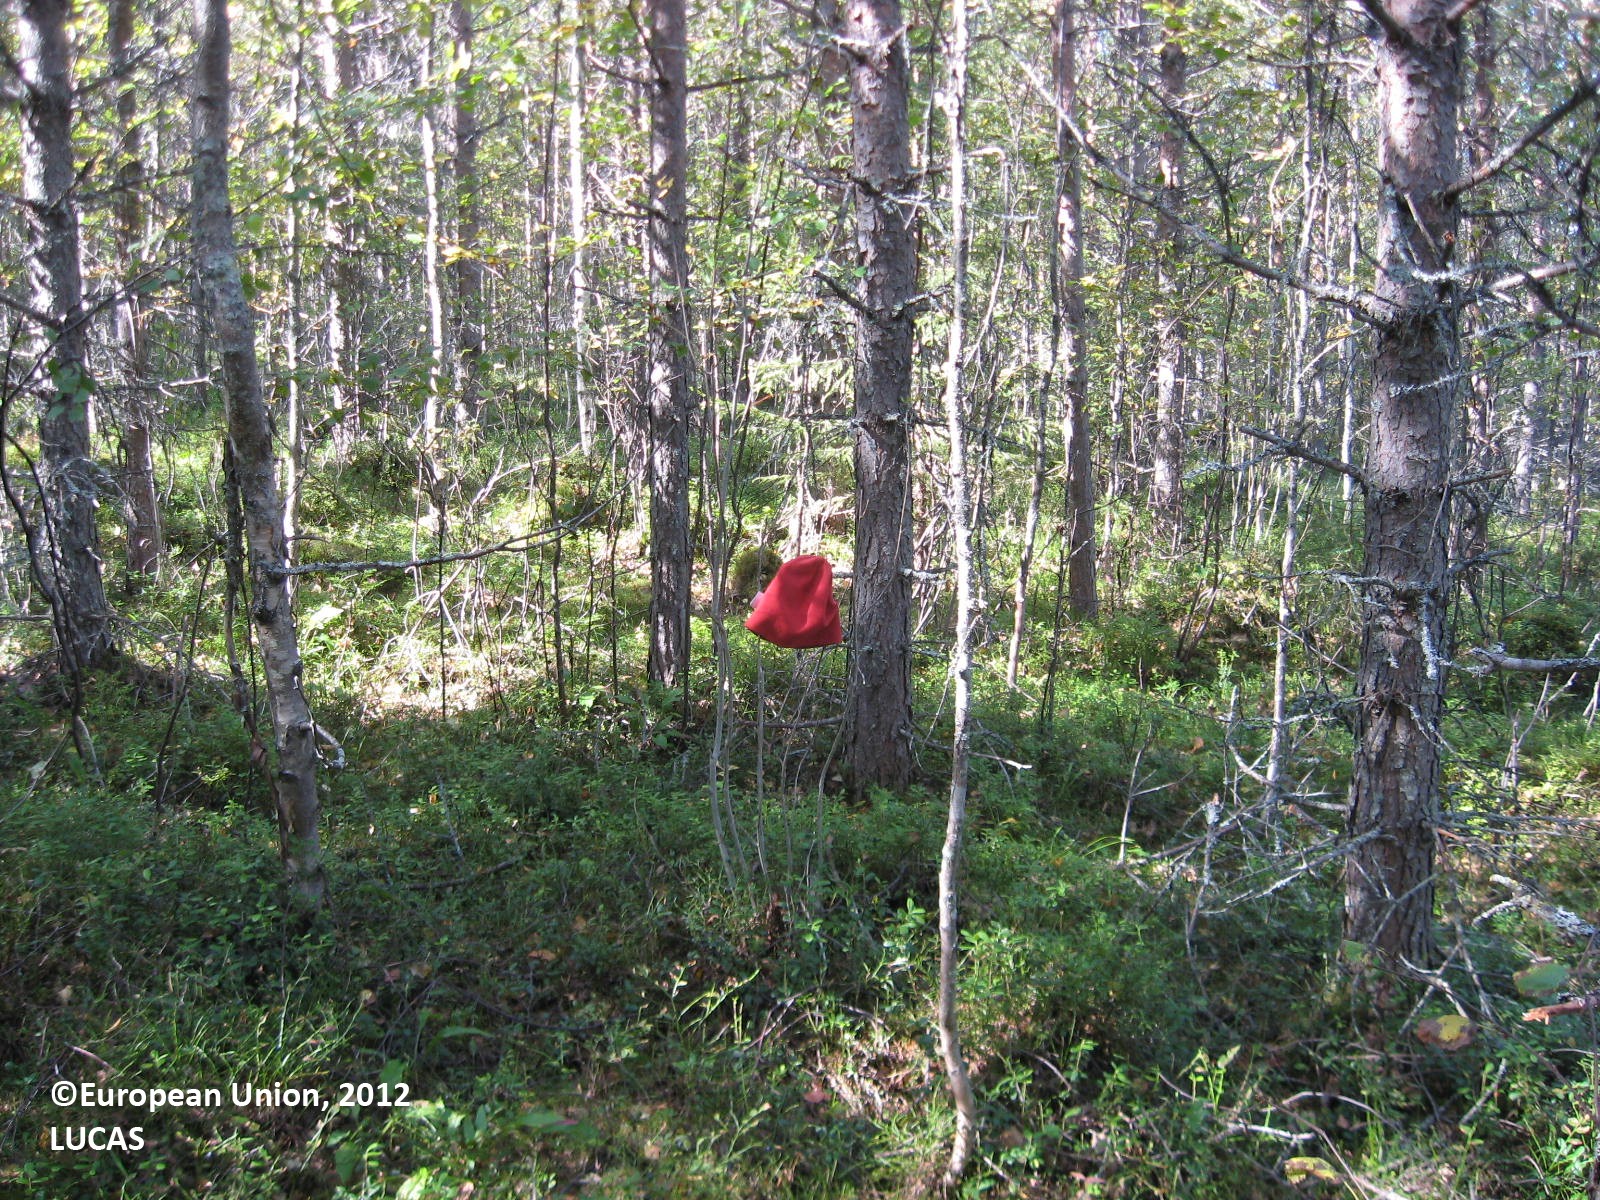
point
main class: Woodland
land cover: Pine dominated coniferous woodland
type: boreal forest
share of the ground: > 75 %
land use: Forestry
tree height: > 5 m
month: August
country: FI
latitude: 63.8021
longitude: 29.9556
